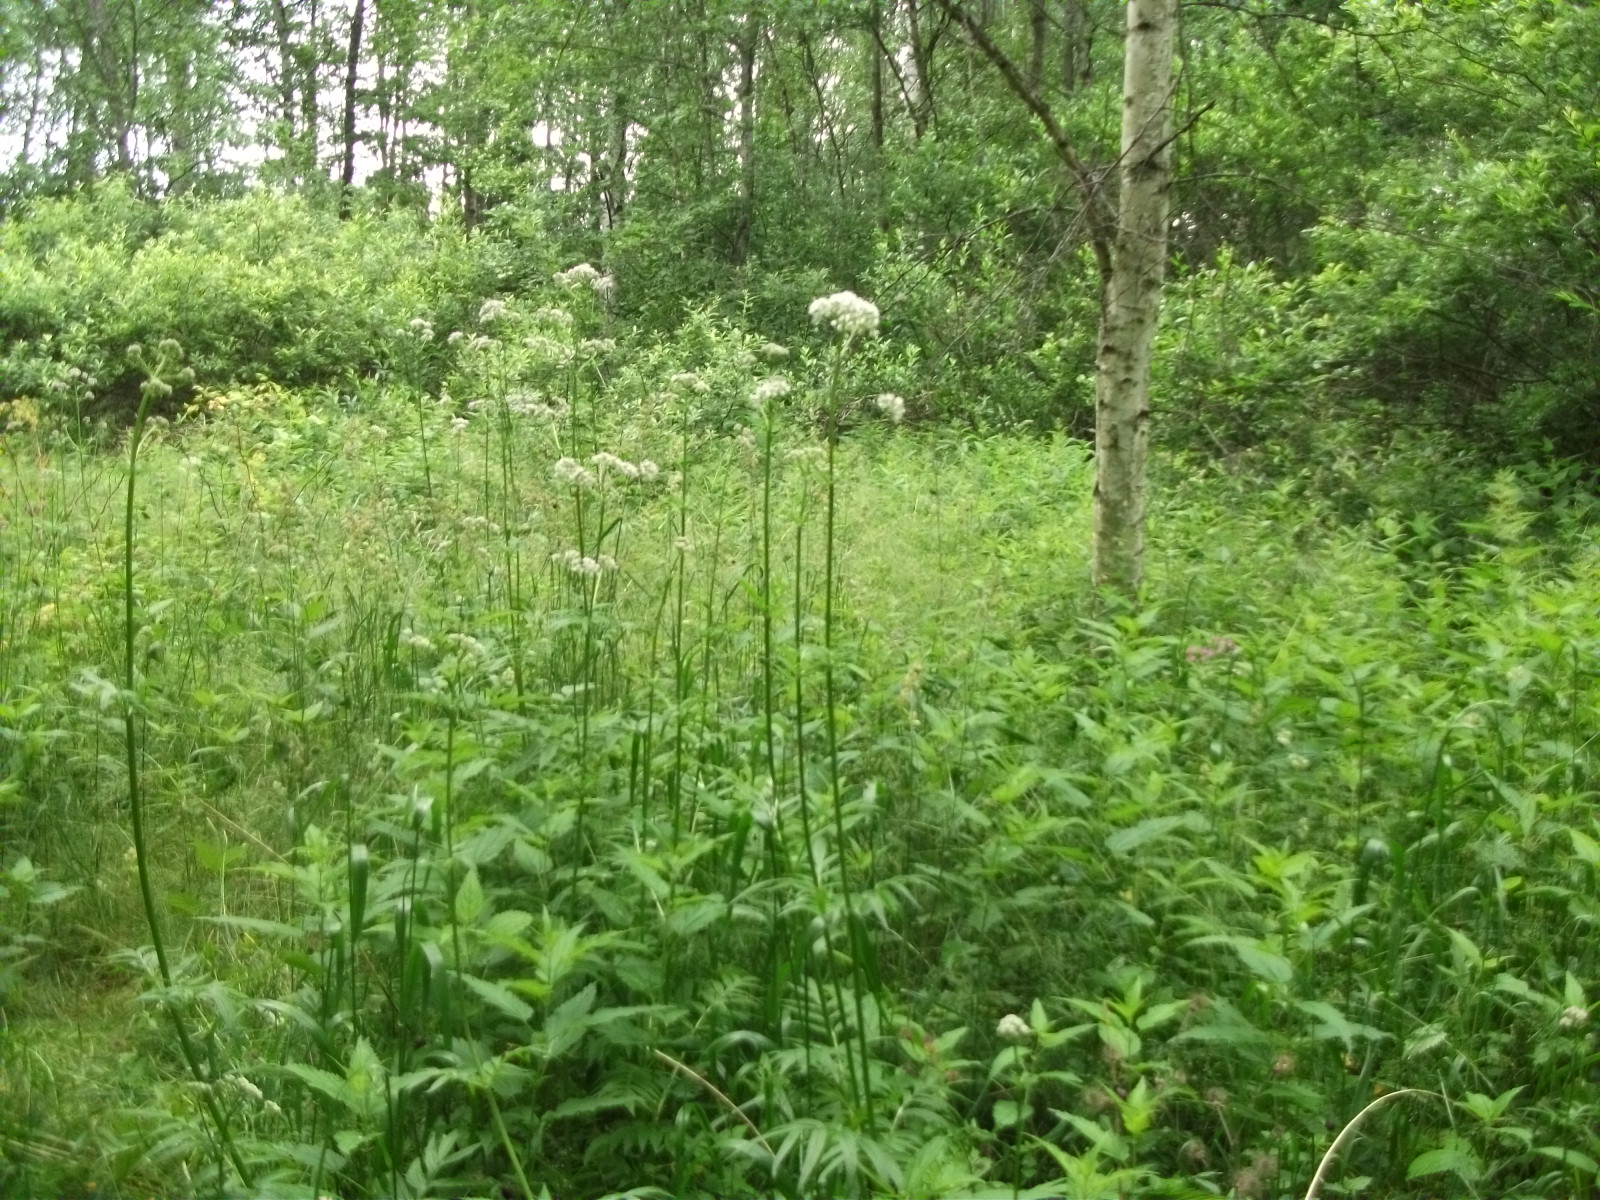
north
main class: Woodland
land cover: Broadleaved woodland
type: non-riverine alder, birch or aspen forest
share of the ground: > 75 %
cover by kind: broadleaved forest trees 90 %, herbaceous plants 10 %
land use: Semi-natural and natural areas not in use
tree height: > 5 m
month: January
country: LV
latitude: 56.8799
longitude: 26.6082
